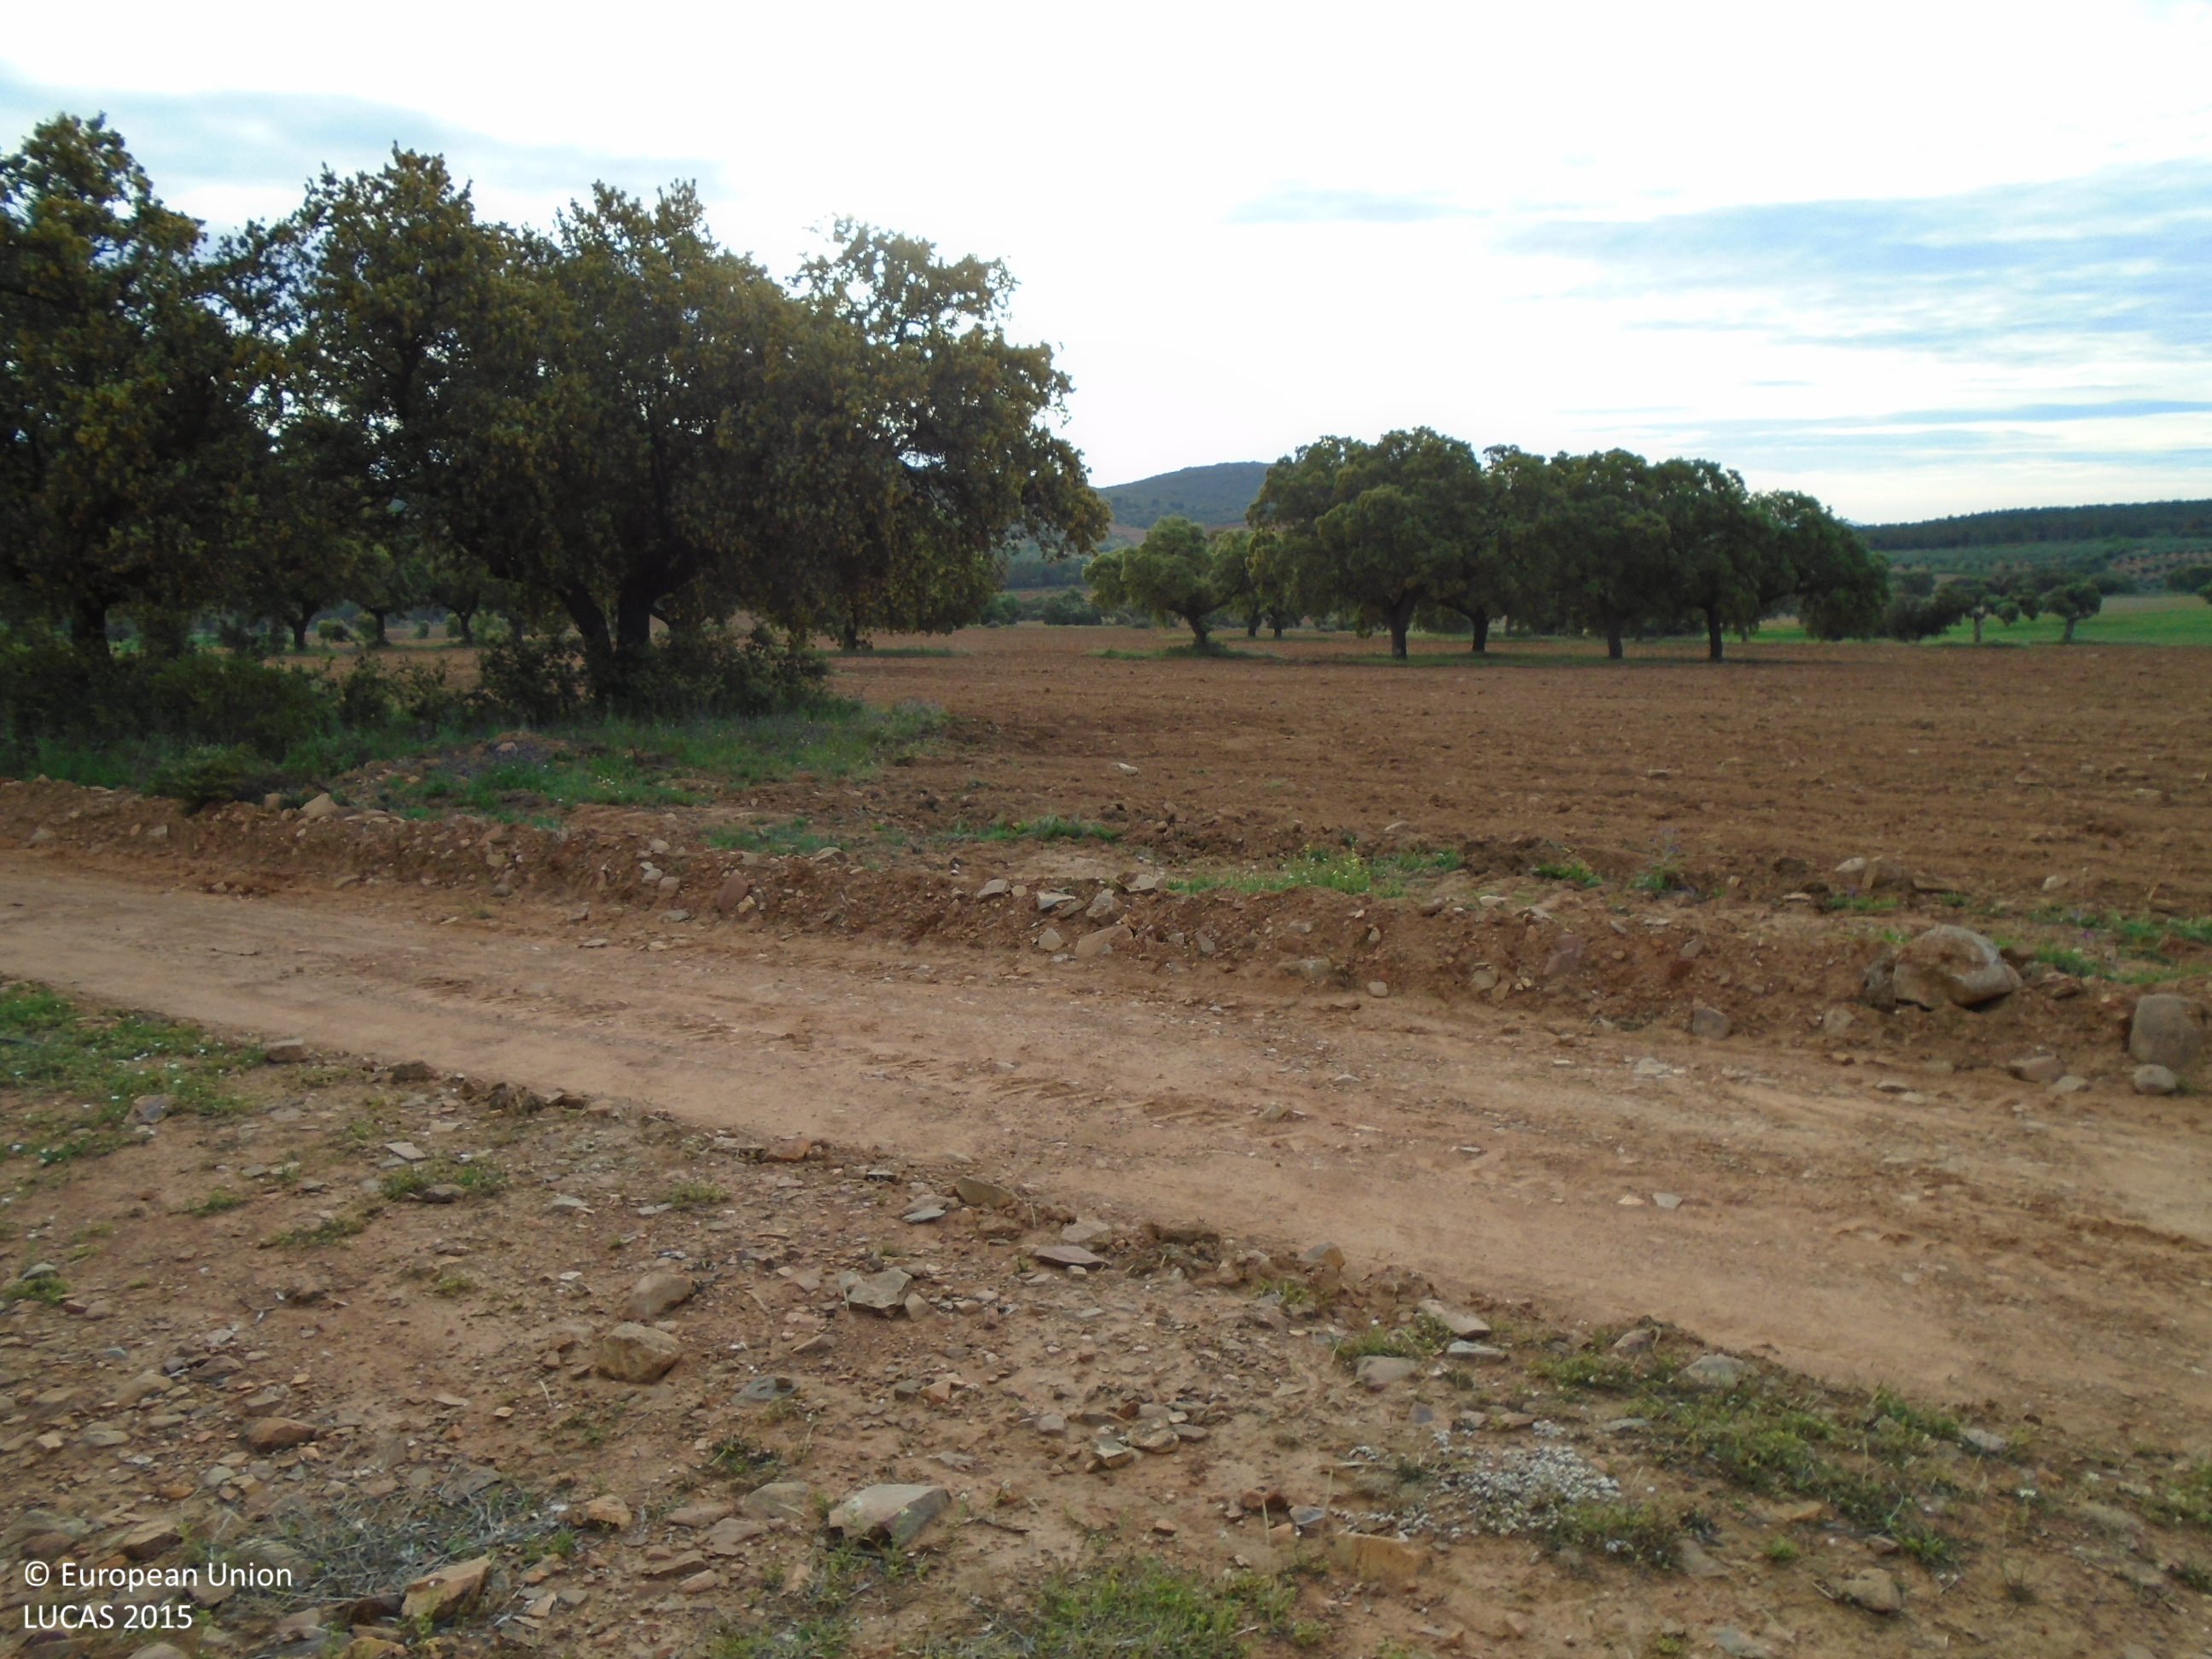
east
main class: Cropland
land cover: Olive groves
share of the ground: 10 - 25 %
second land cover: Other bare soil
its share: > 75 %
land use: Agriculture (excluding fallow land and kitchen gardens)
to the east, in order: Olive groves; Other bare soil; Grass margins; Tracks; Grass margins; Other bare soil; Grass margins; Mixed cereals for fodder
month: May
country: ES
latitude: 39.6821
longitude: -4.6027
